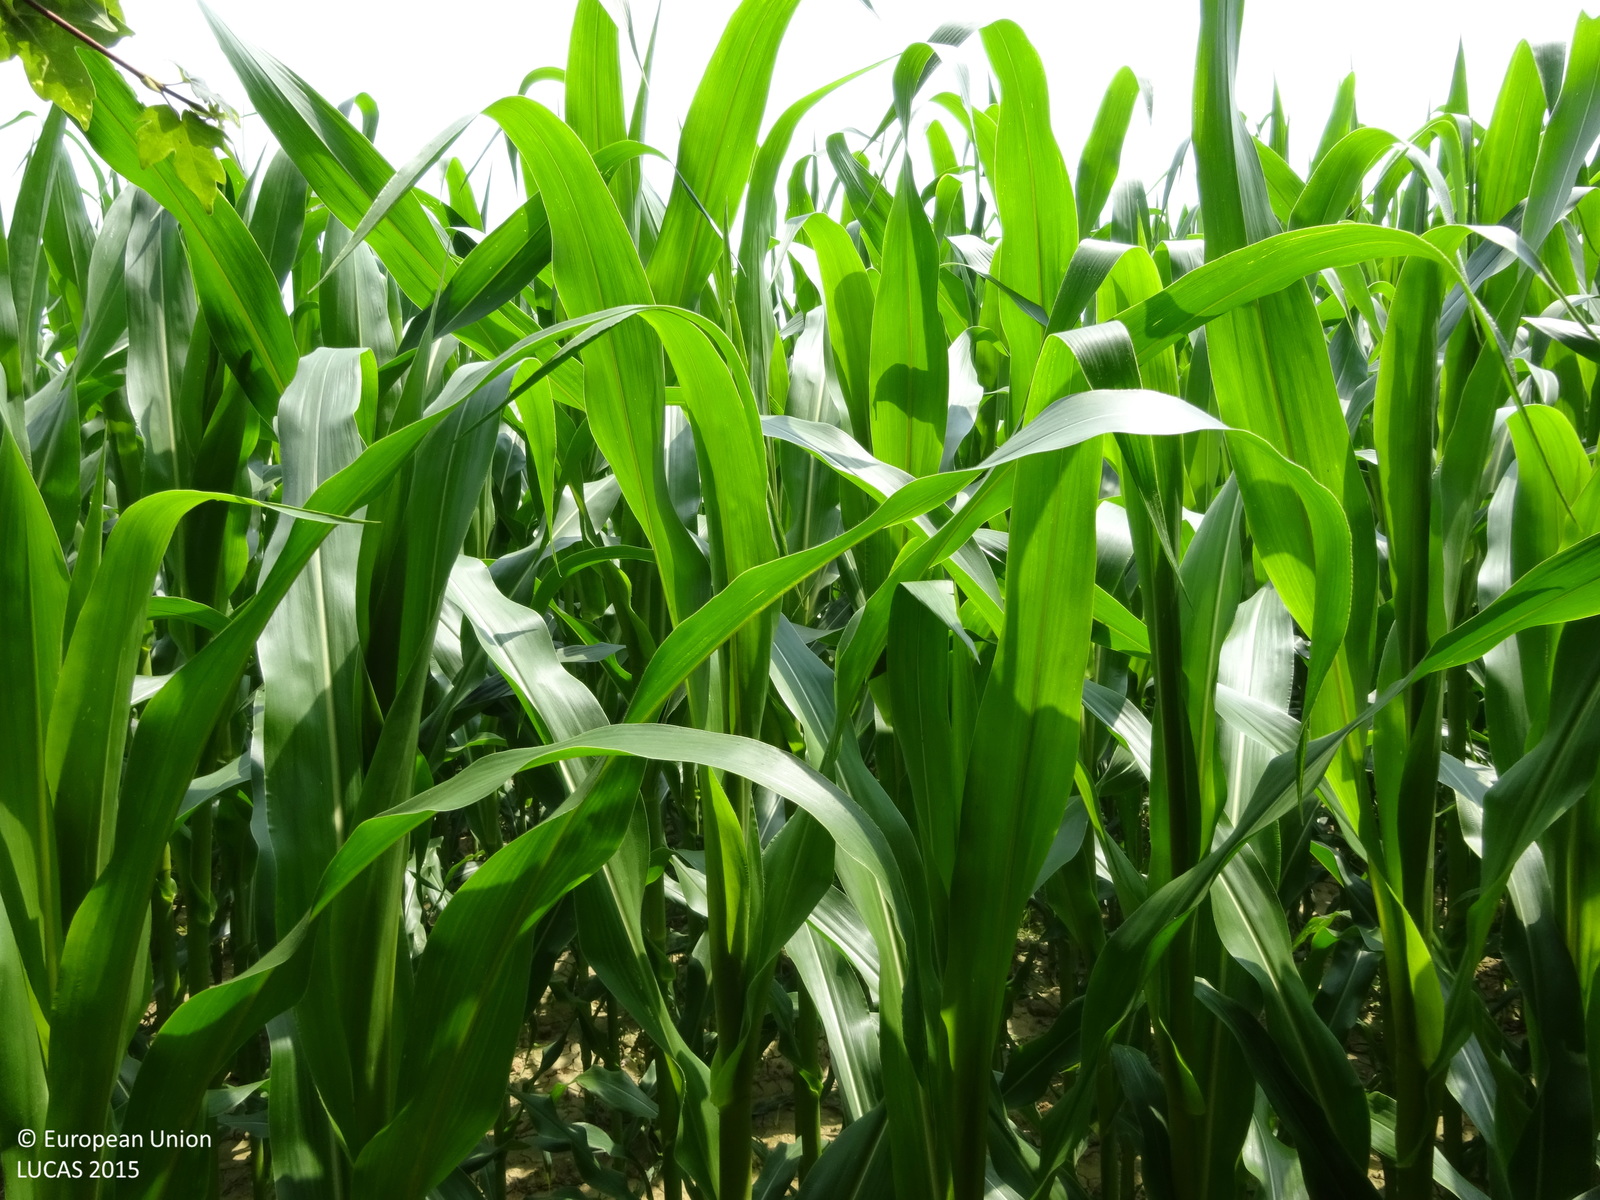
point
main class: Cropland
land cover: Maize
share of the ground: > 75 %
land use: Agriculture (excluding fallow land and kitchen gardens)
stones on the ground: < 10 %
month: July
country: AT
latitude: 46.9423
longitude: 15.9782
